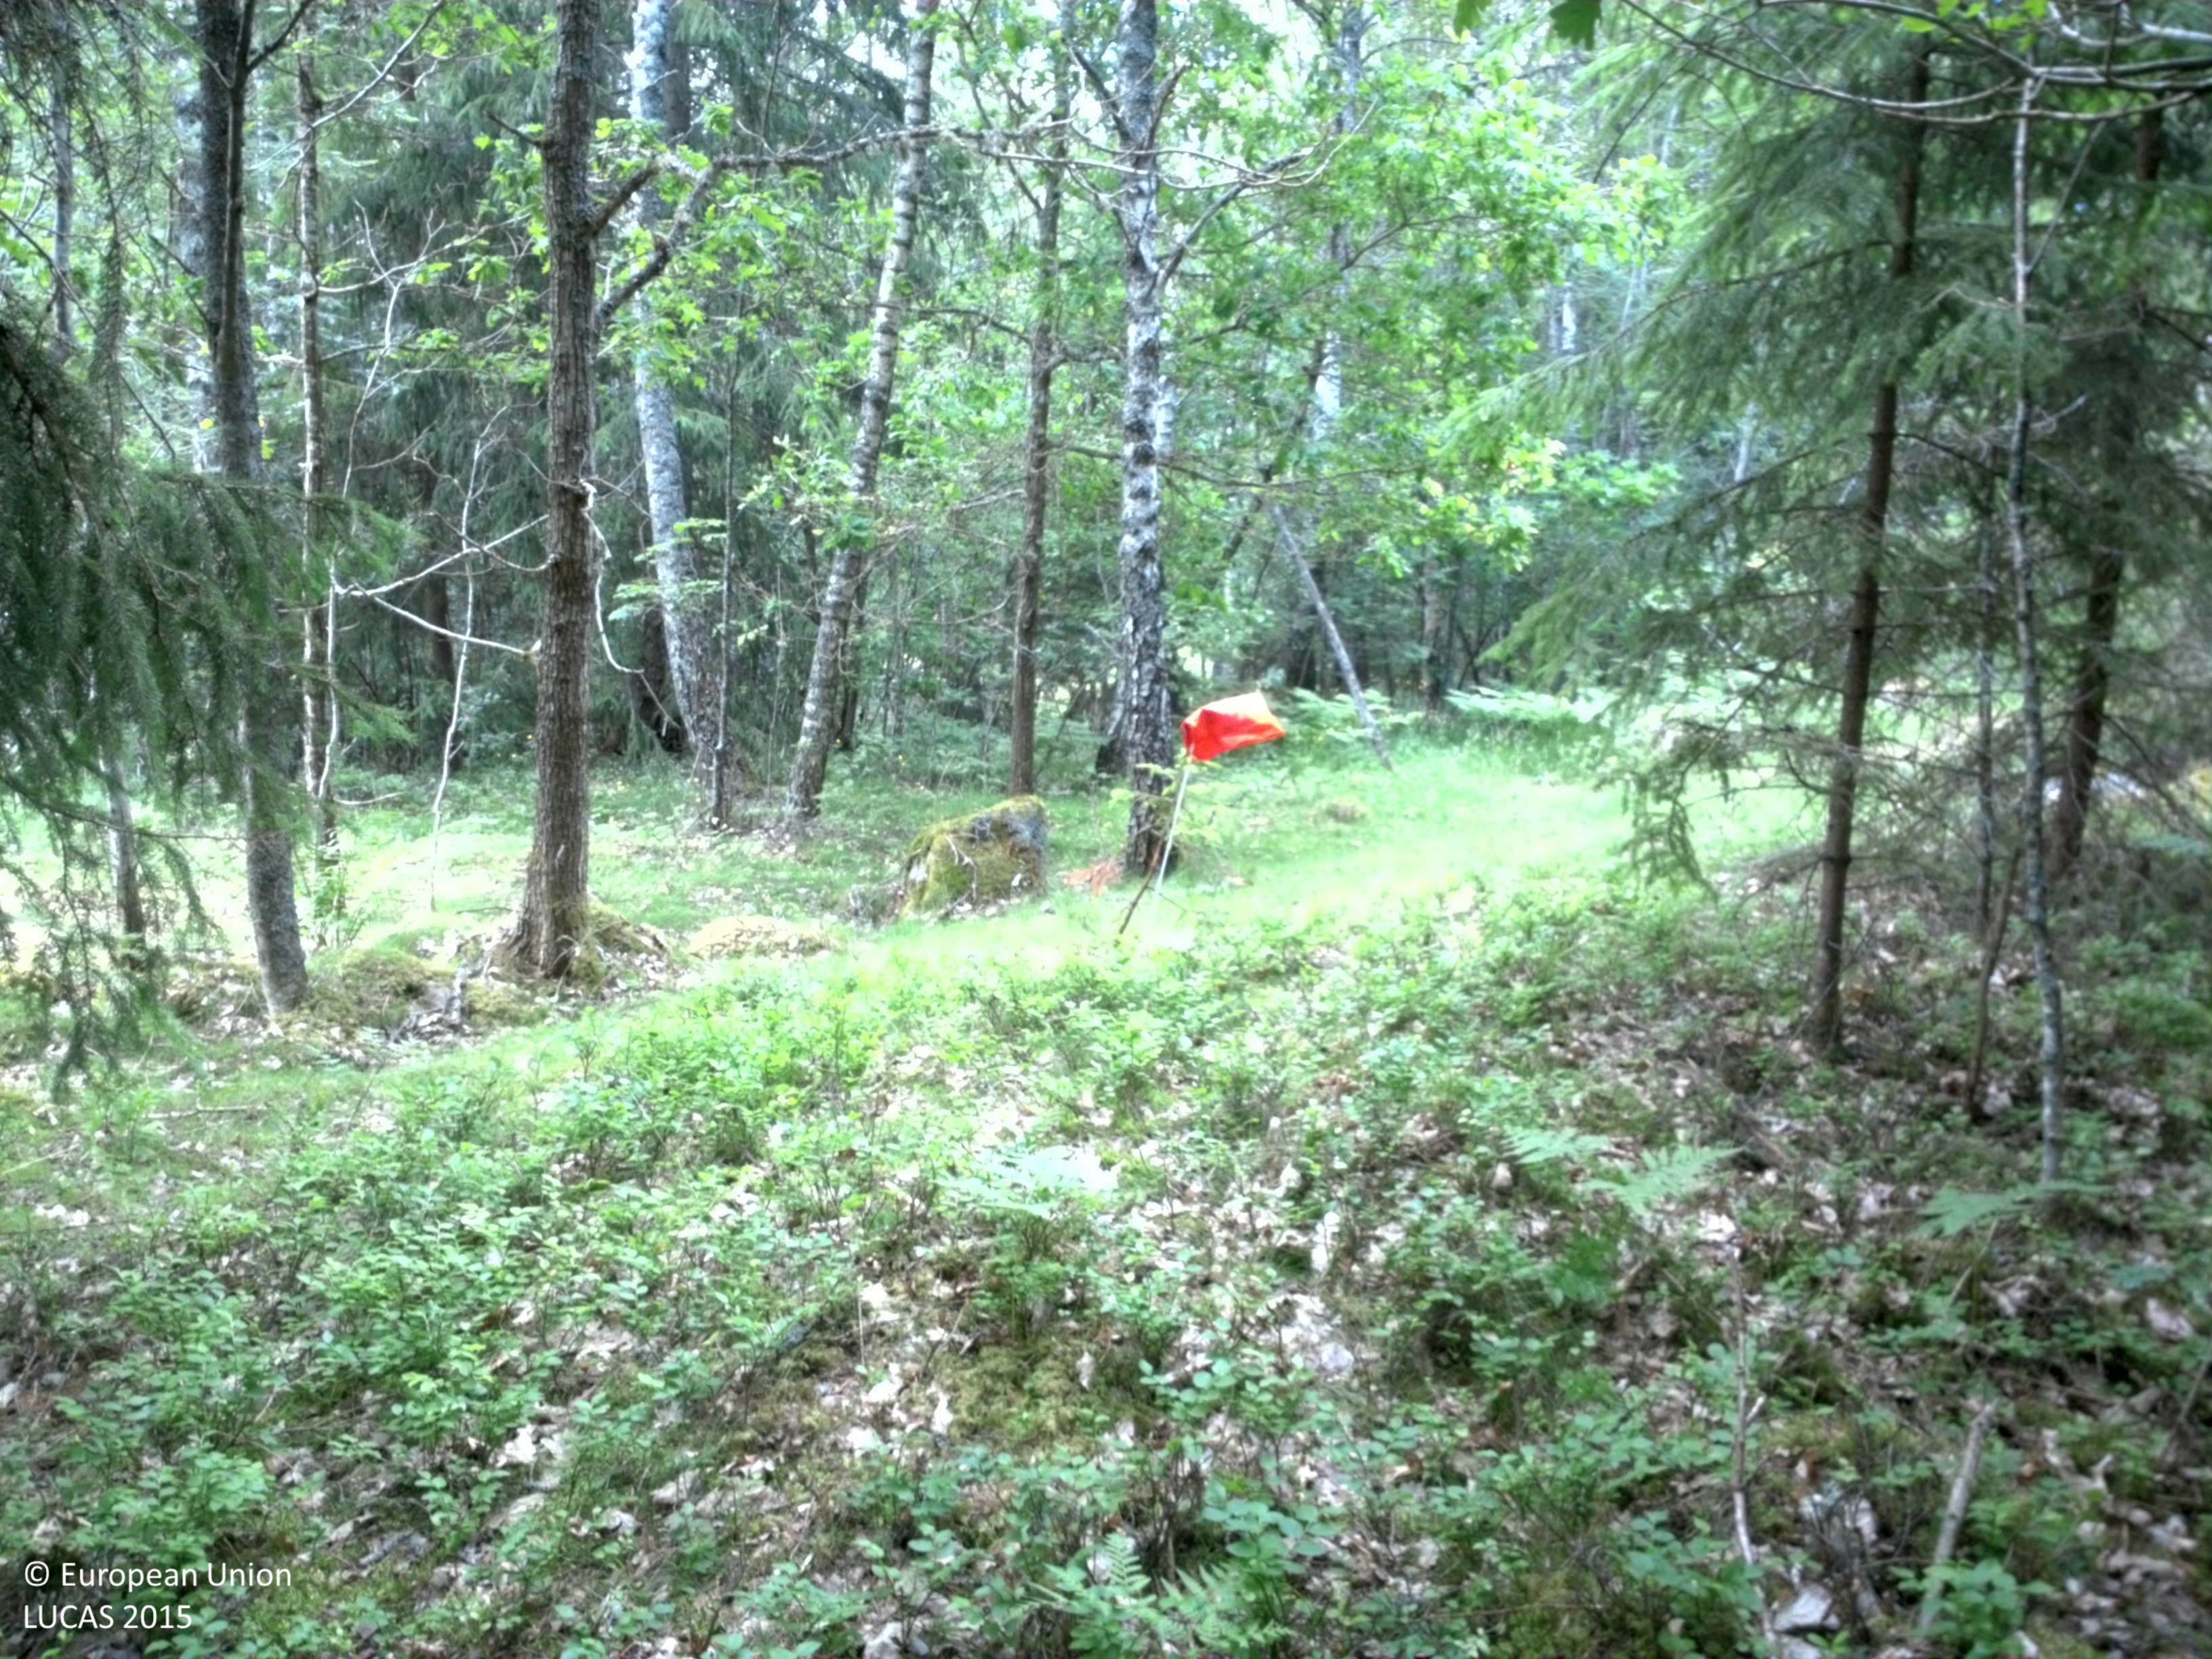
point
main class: Woodland
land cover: Spruce dominated mixed woodland
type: boreal forest
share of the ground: 50 - 75 %
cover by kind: coniferous forest trees 40 %, herbaceous plants 30 %, broadleaved forest trees 20 %, lichens and mosses 10 %
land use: Forestry
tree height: > 5 m
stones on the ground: < 10 %
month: June
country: SE
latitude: 58.7310
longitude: 15.6765
